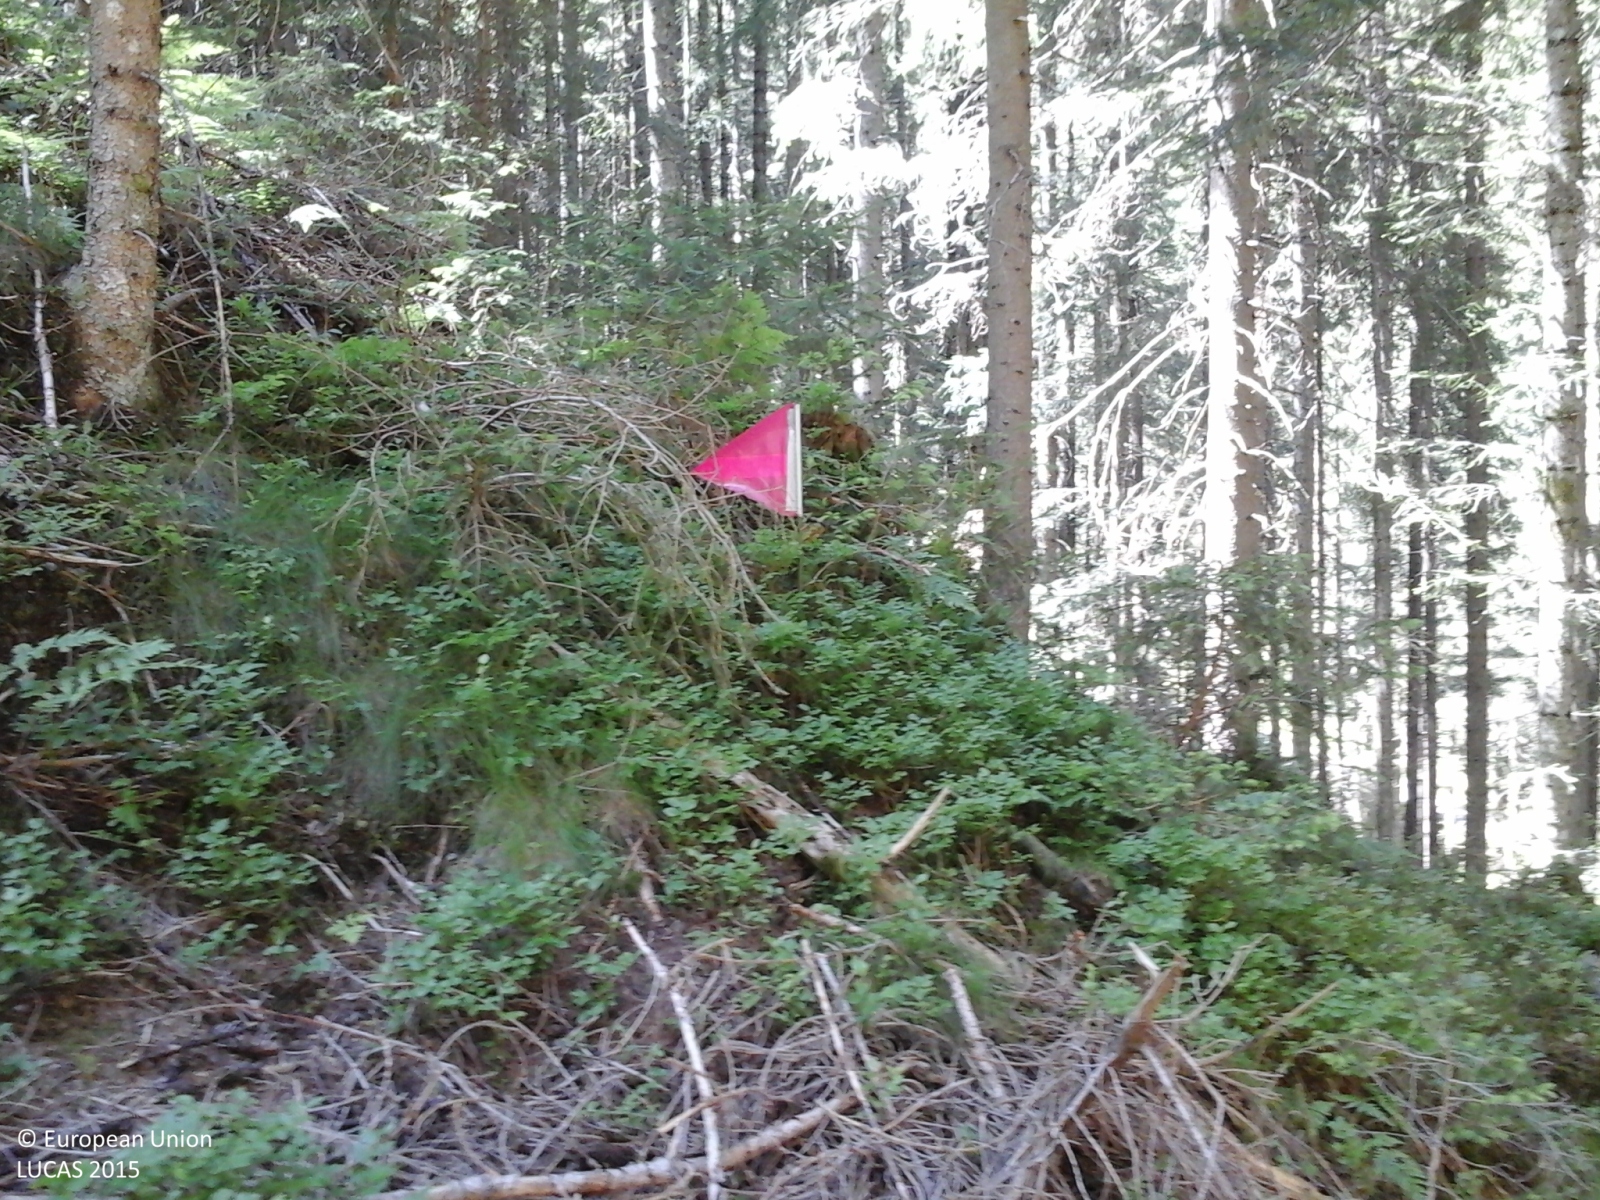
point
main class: Woodland
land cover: Spruce dominated coniferous woodland
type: alpine coniferous forest
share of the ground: > 75 %
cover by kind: coniferous forest trees 100 %
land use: Forestry
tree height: > 5 m
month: June
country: IT
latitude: 46.7358
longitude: 11.5818
